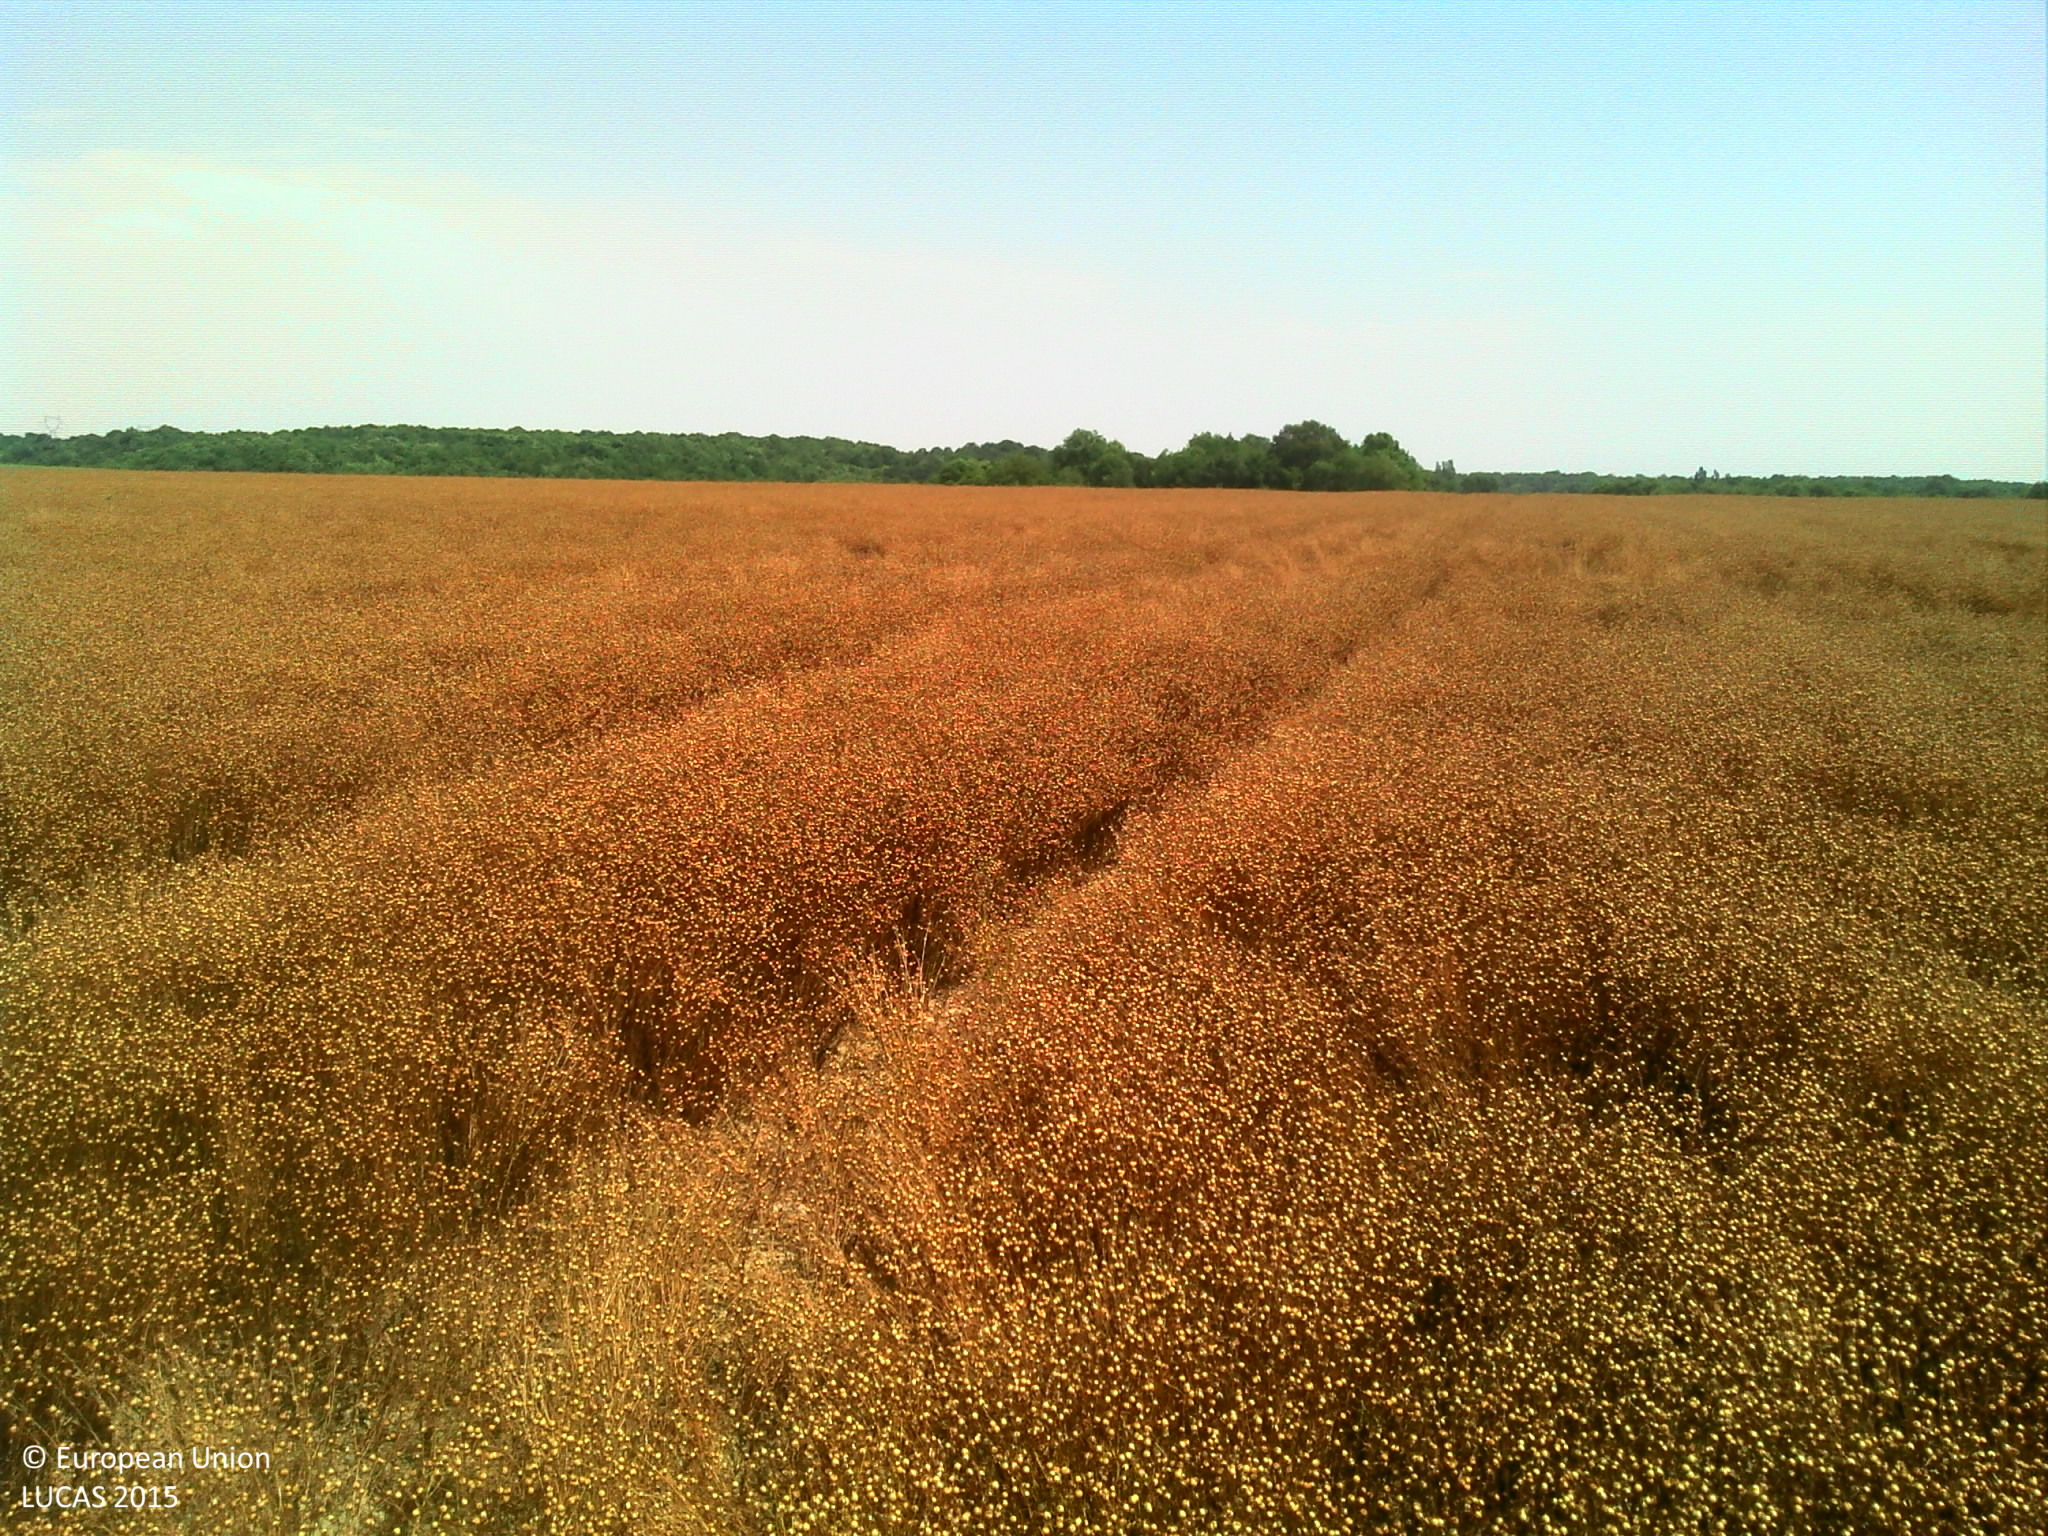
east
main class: Cropland
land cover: Other fibre and oleaginous crops
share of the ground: > 75 %
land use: Agriculture (excluding fallow land and kitchen gardens)
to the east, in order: Other fibre and oleaginous crops; Grass margins; Paved roads, cycling and walking lanes; Grass margins; Ditches and canals; Clovers
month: July
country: FR
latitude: 47.5393
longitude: 0.6937
